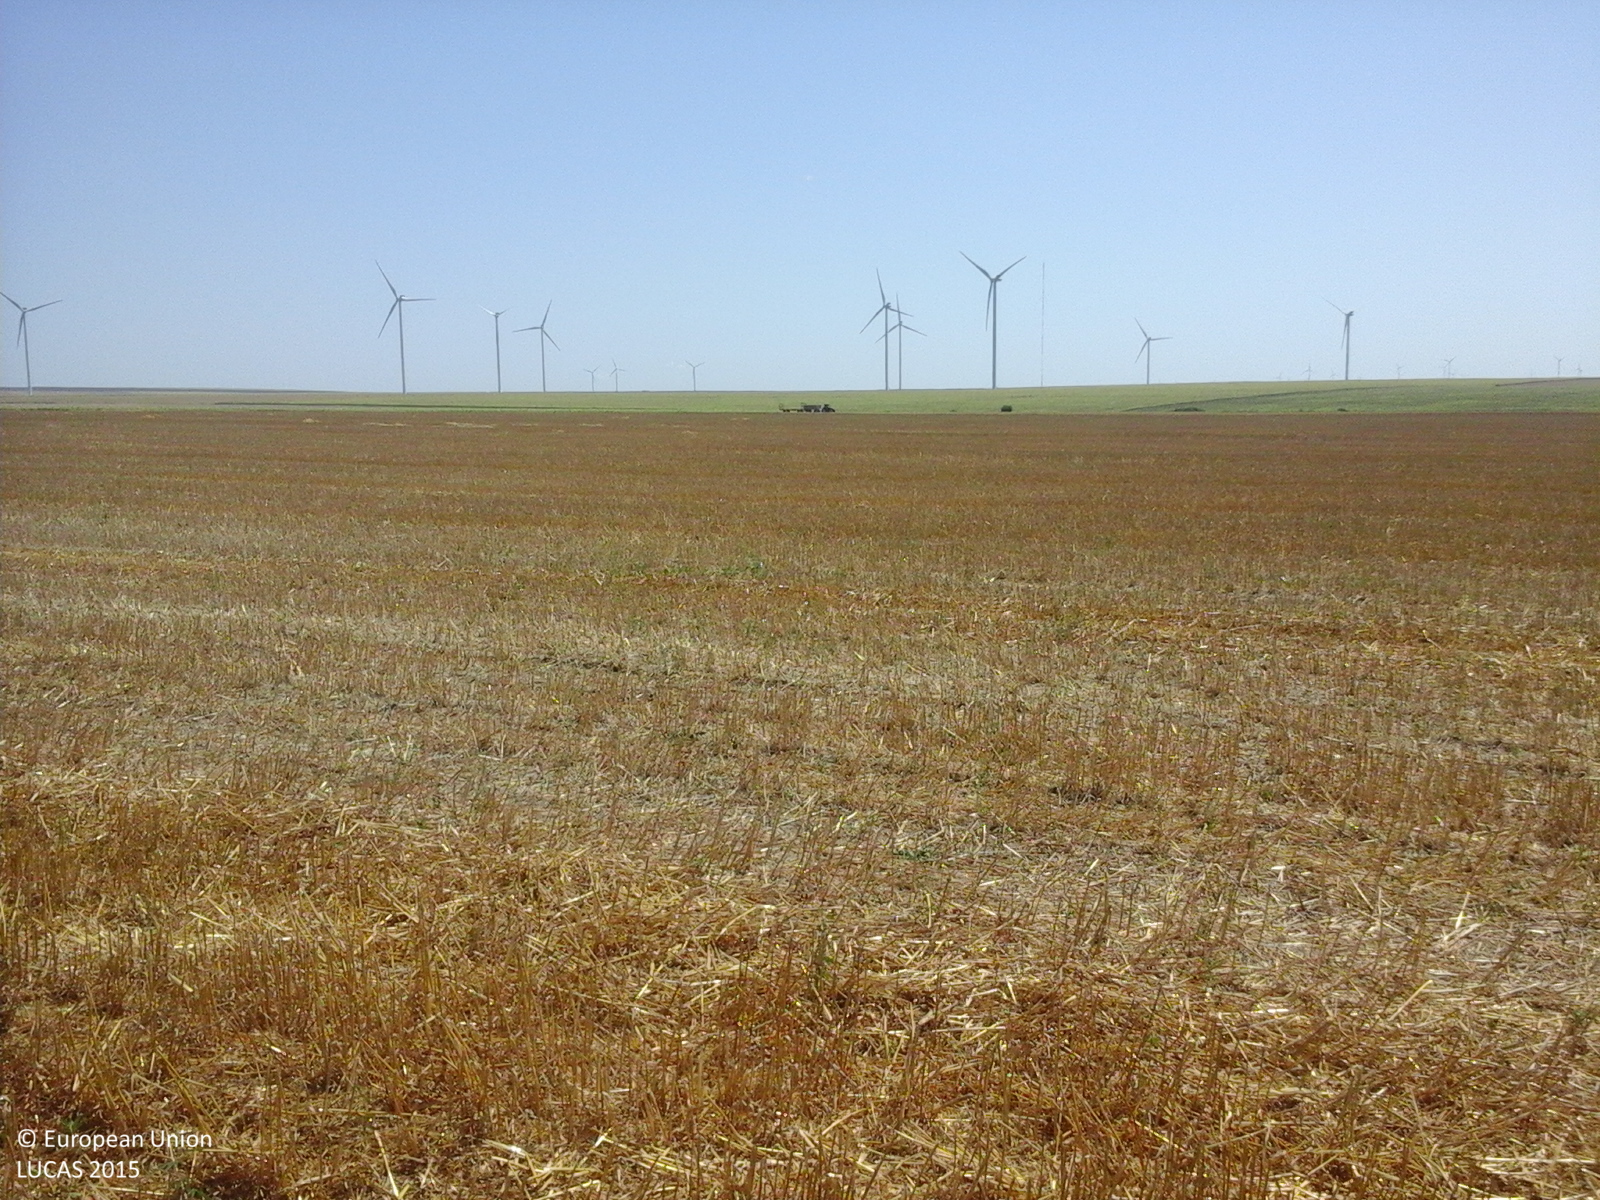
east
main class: Cropland
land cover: Common wheat
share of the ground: 50 - 75 %
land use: Agriculture (excluding fallow land and kitchen gardens)
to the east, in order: Common wheat
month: August
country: RO
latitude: 44.5680
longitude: 28.2090
